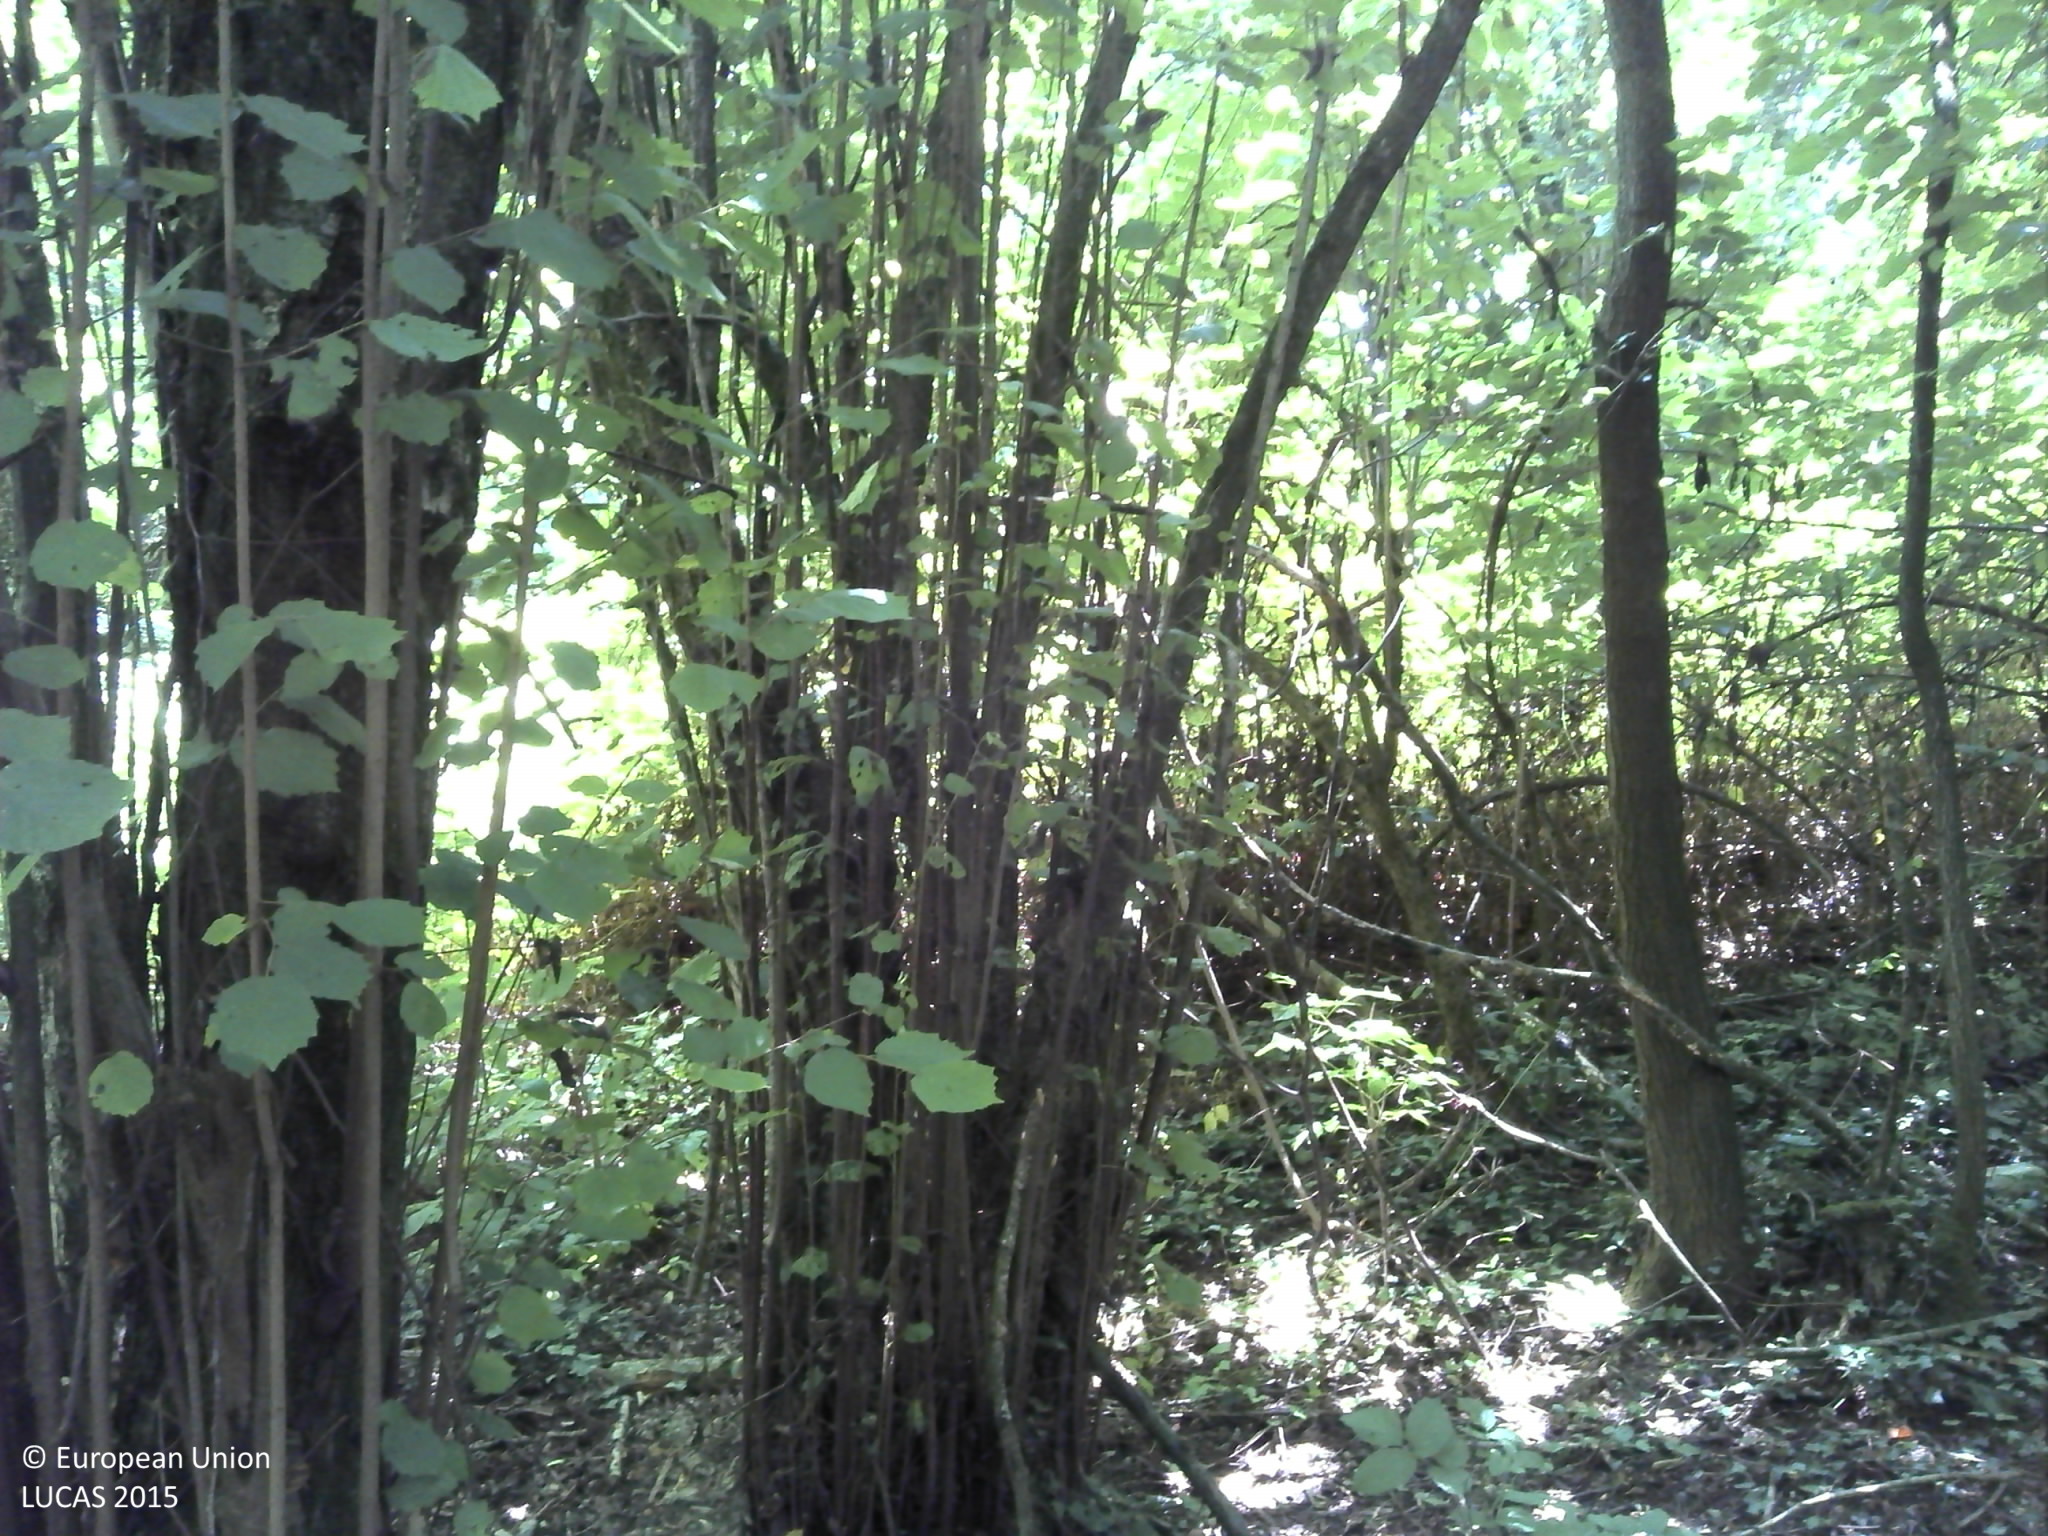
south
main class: Shrubland
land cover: Shrubland with sparse tree cover
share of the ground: > 75 %
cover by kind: shrubs 95 %, broadleaved forest trees 5 %
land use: Semi-natural and natural areas not in use
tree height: < 5 m
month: July
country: HR
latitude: 45.5350
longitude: 16.8503
